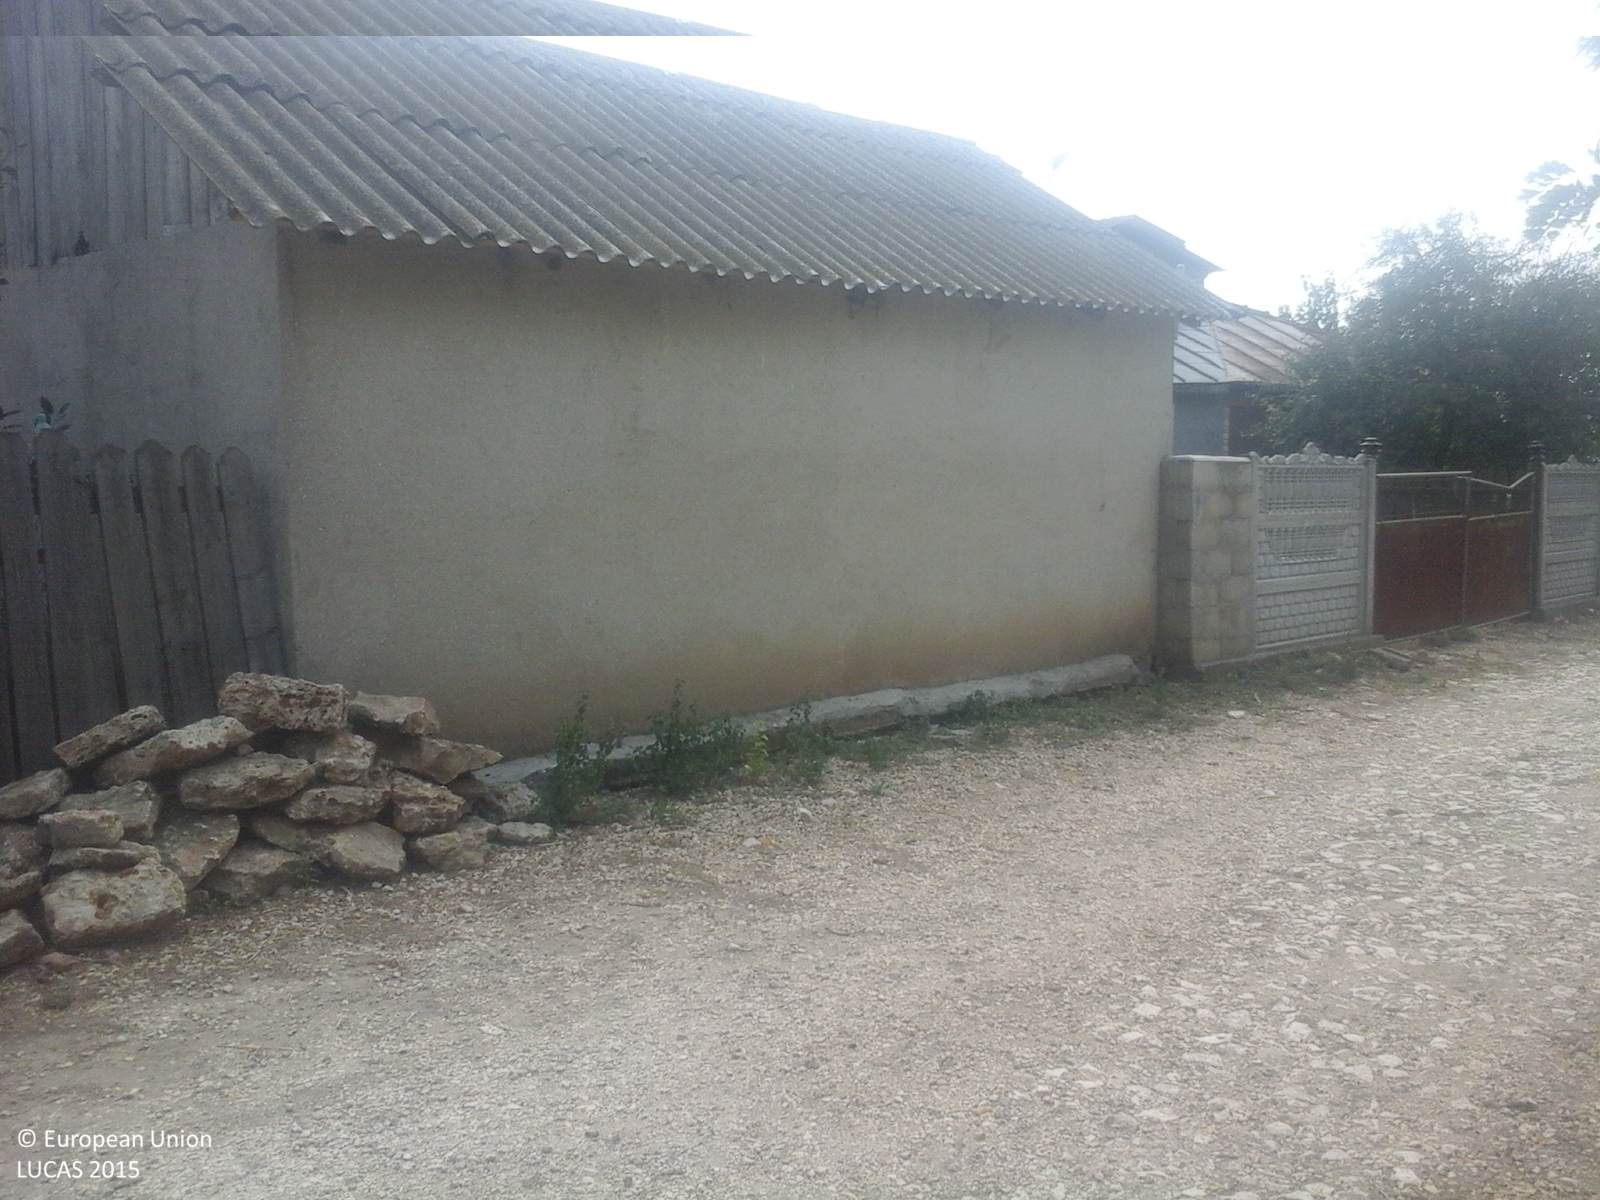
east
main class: Grassland
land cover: Spontaneously vegetated surfaces
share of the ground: > 75 %
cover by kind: herbaceous plants 100 %
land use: Fallow land
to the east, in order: Spontaneously vegetated surfaces; Artificial constructions in urban areas; Maize; Artificial constructions in urban areas
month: August
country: RO
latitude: 43.9013
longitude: 28.2228
